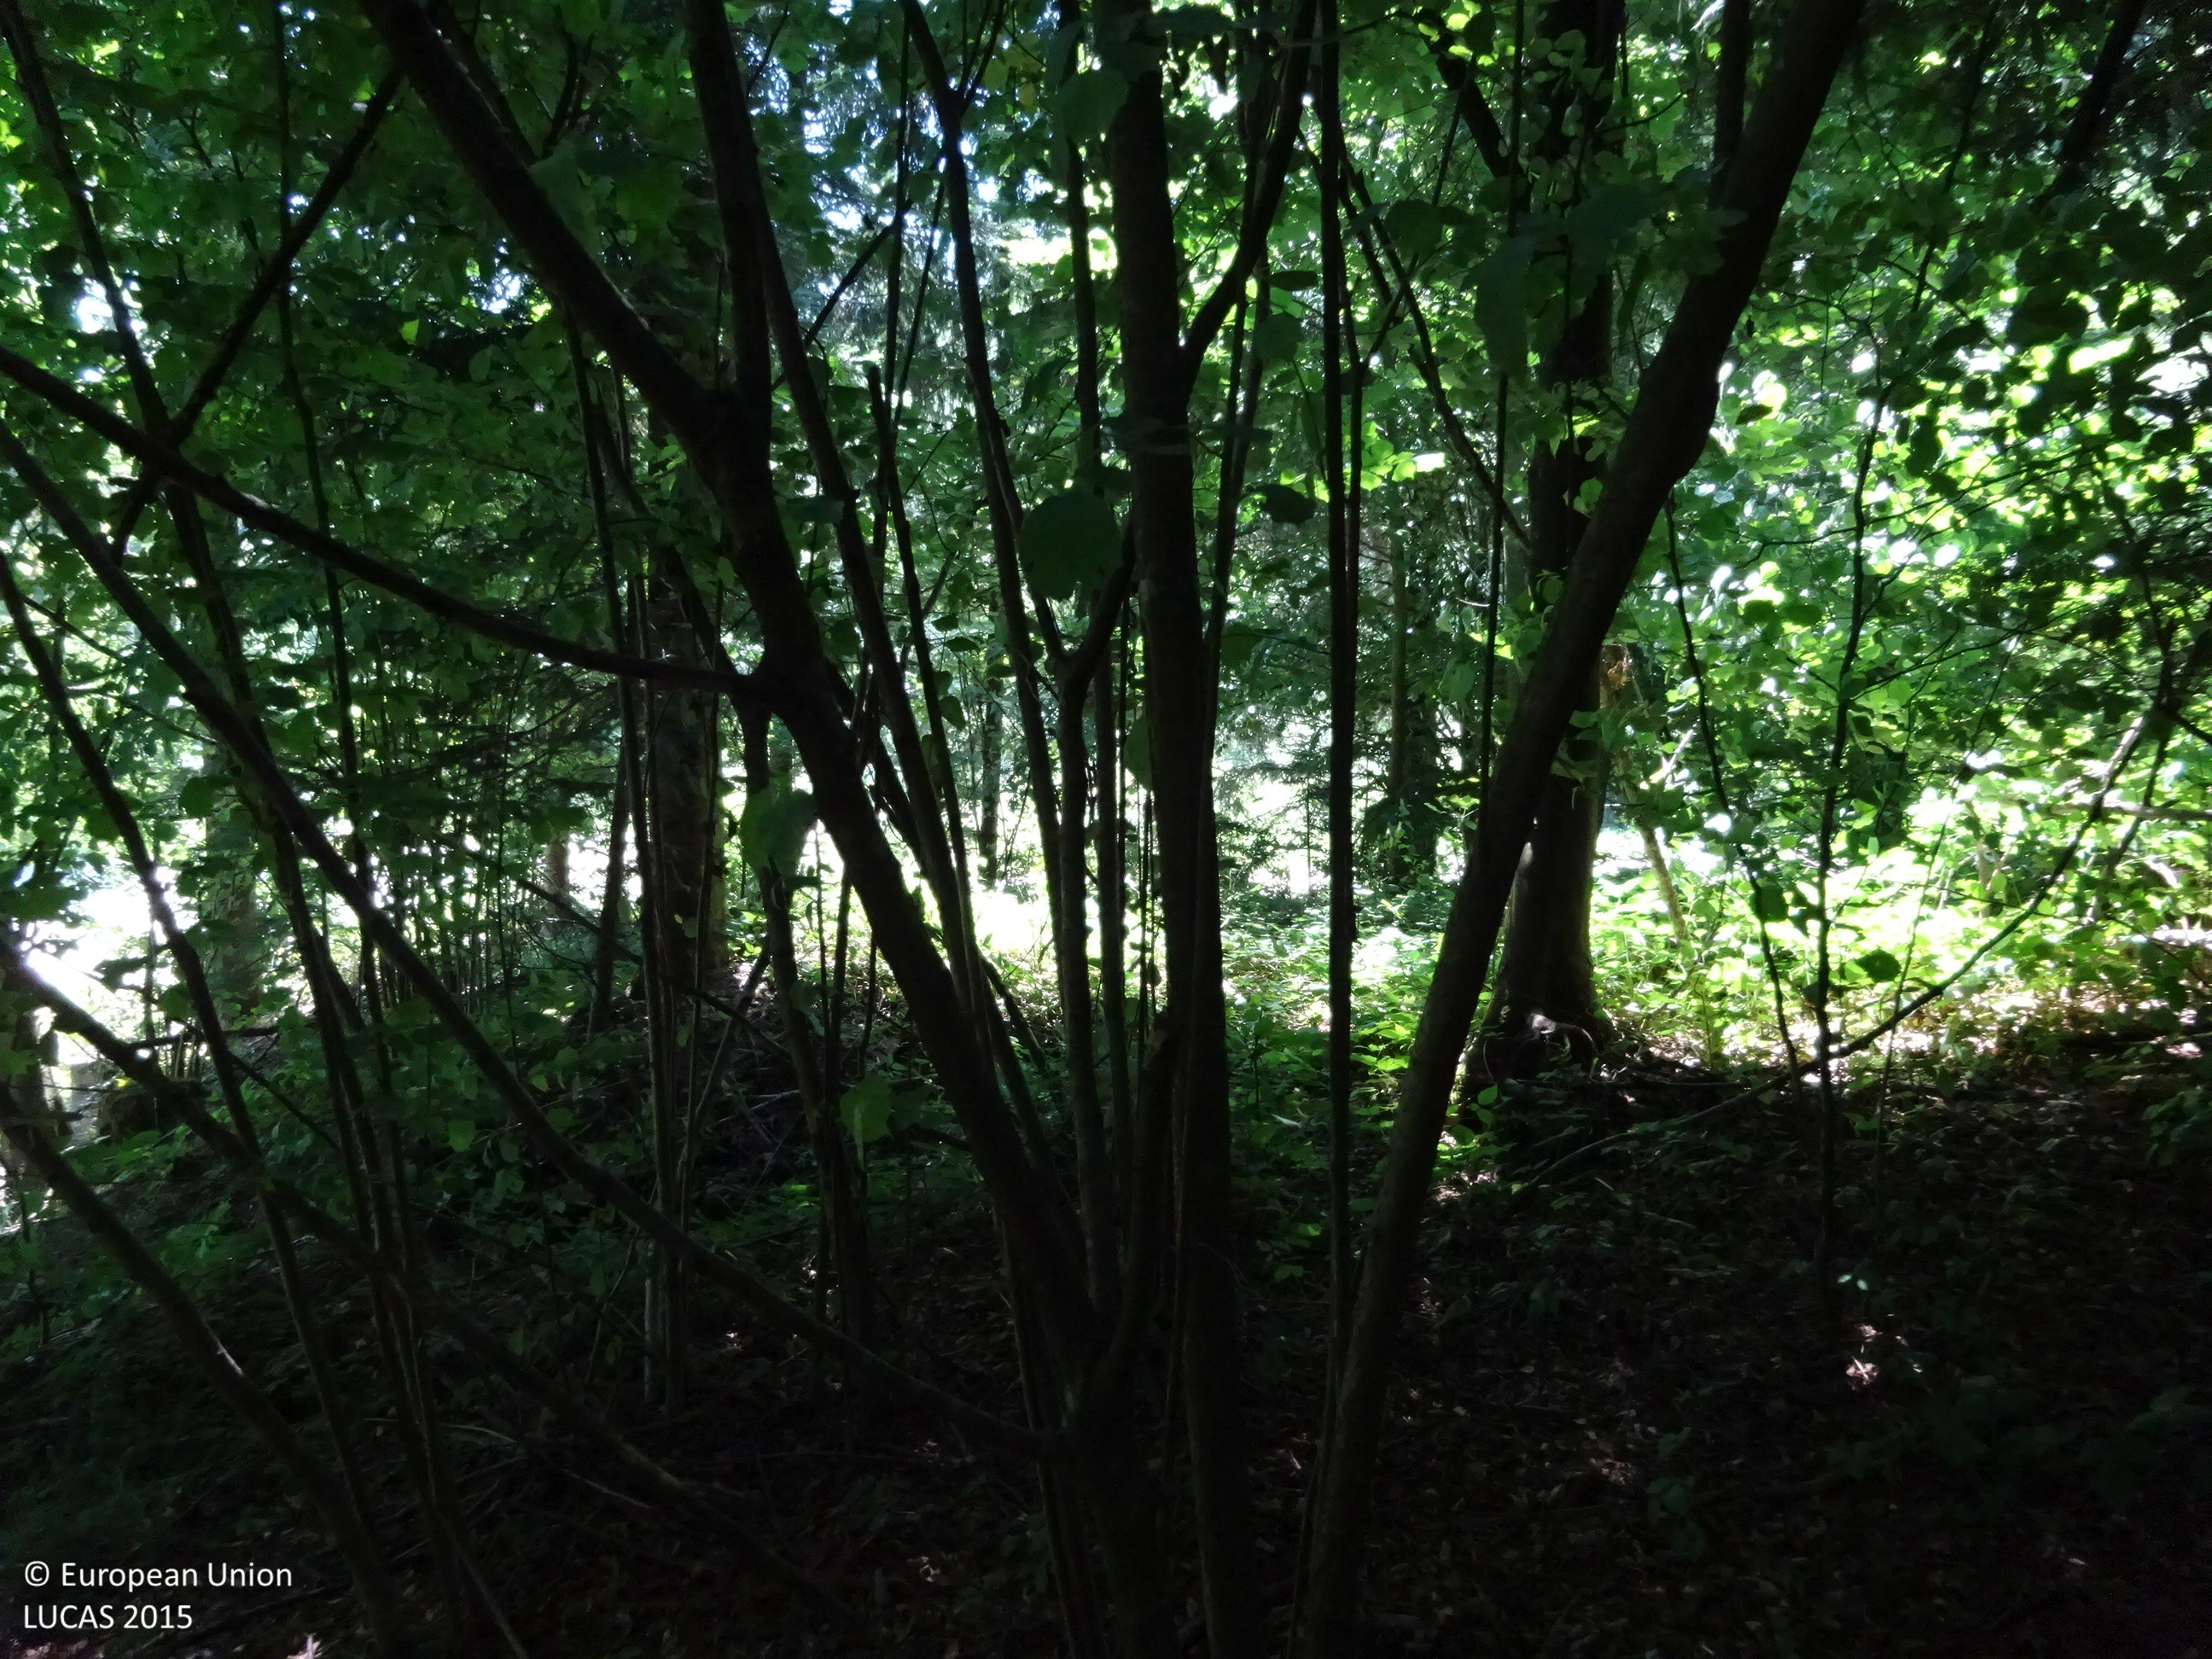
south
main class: Woodland
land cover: Other mixed woodland
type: alpine coniferous forest
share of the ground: > 75 %
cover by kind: shrubs 45 %, coniferous forest trees 30 %, broadleaved forest trees 25 %
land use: Forestry
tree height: > 5 m
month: August
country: AT
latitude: 47.4954
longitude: 16.0953
